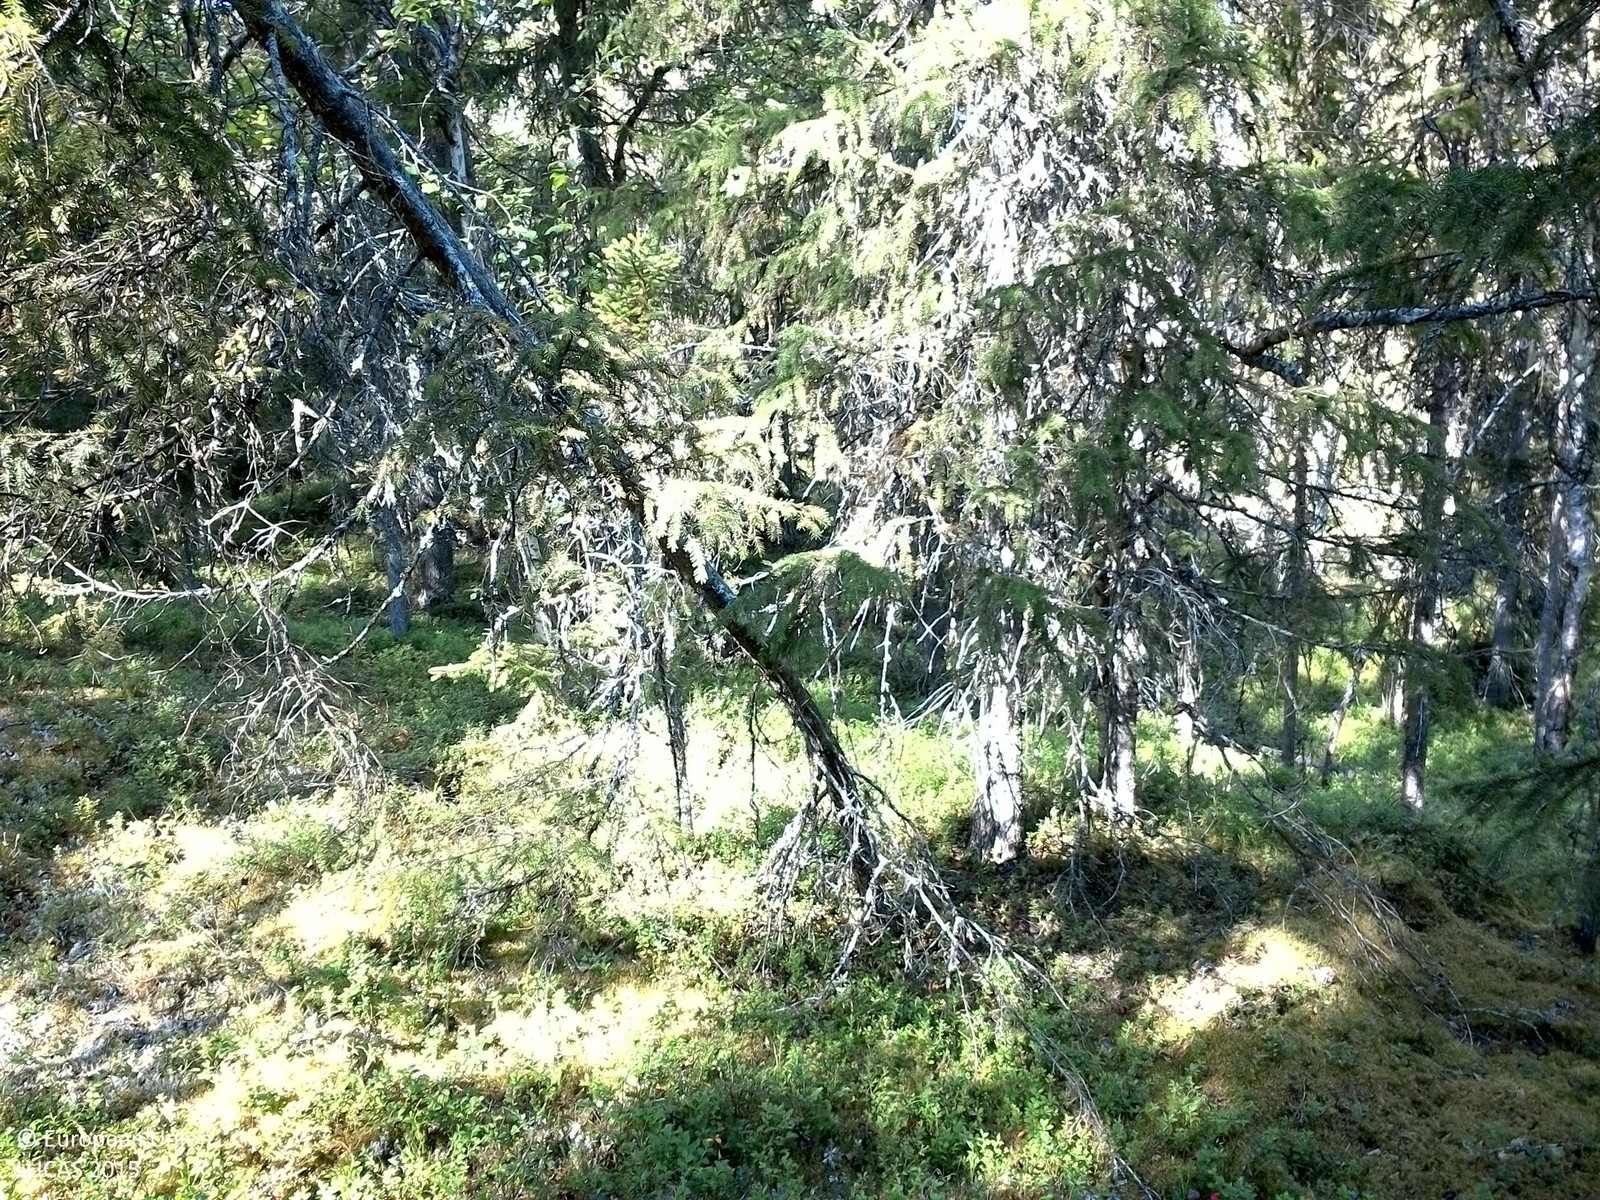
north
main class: Woodland
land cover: Spruce dominated coniferous woodland
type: boreal forest
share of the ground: 50 - 75 %
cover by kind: coniferous forest trees 55 %, shrubs 25 %, broadleaved forest trees 10 %, herbaceous plants 10 %
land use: Forestry
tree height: > 5 m
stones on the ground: < 10 %
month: August
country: SE
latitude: 63.9636
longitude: 16.7705
